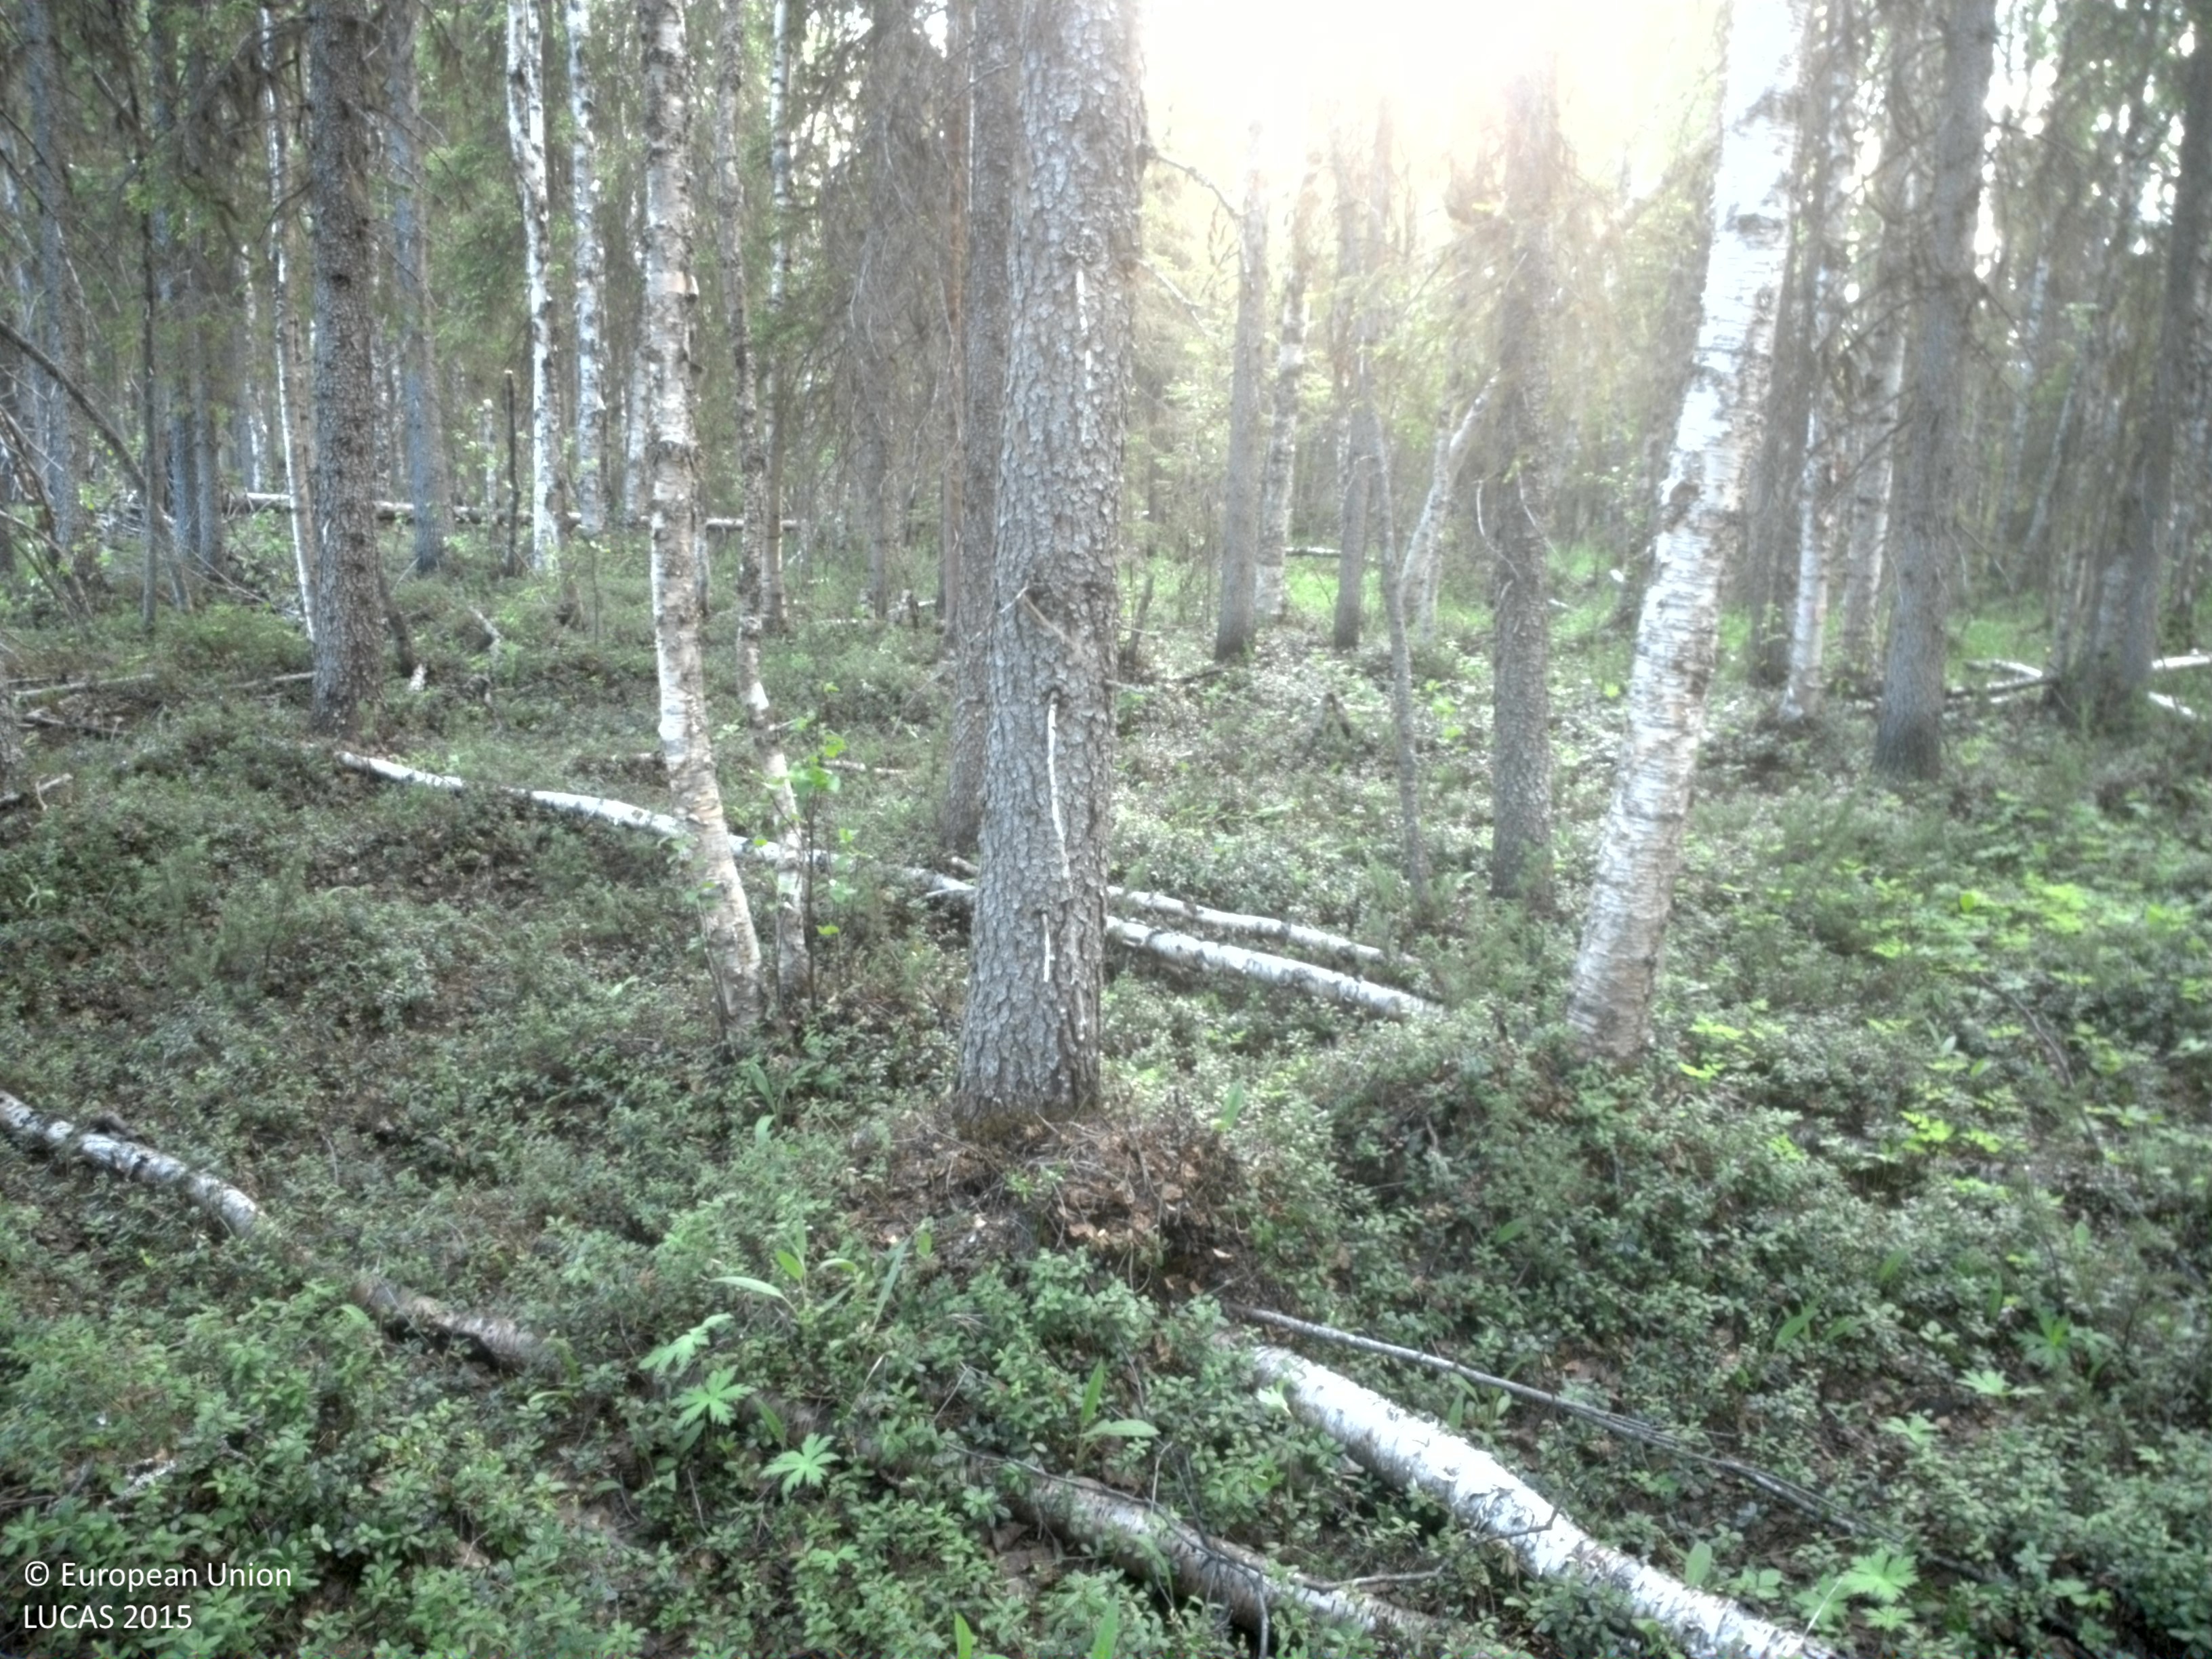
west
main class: Woodland
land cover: Spruce dominated mixed woodland
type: boreal forest
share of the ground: 50 - 75 %
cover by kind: shrubs 45 %, coniferous forest trees 35 %, broadleaved forest trees 15 %, herbaceous plants 5 %
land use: Forestry
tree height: > 5 m
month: June
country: SE
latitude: 67.0991
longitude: 21.6777
